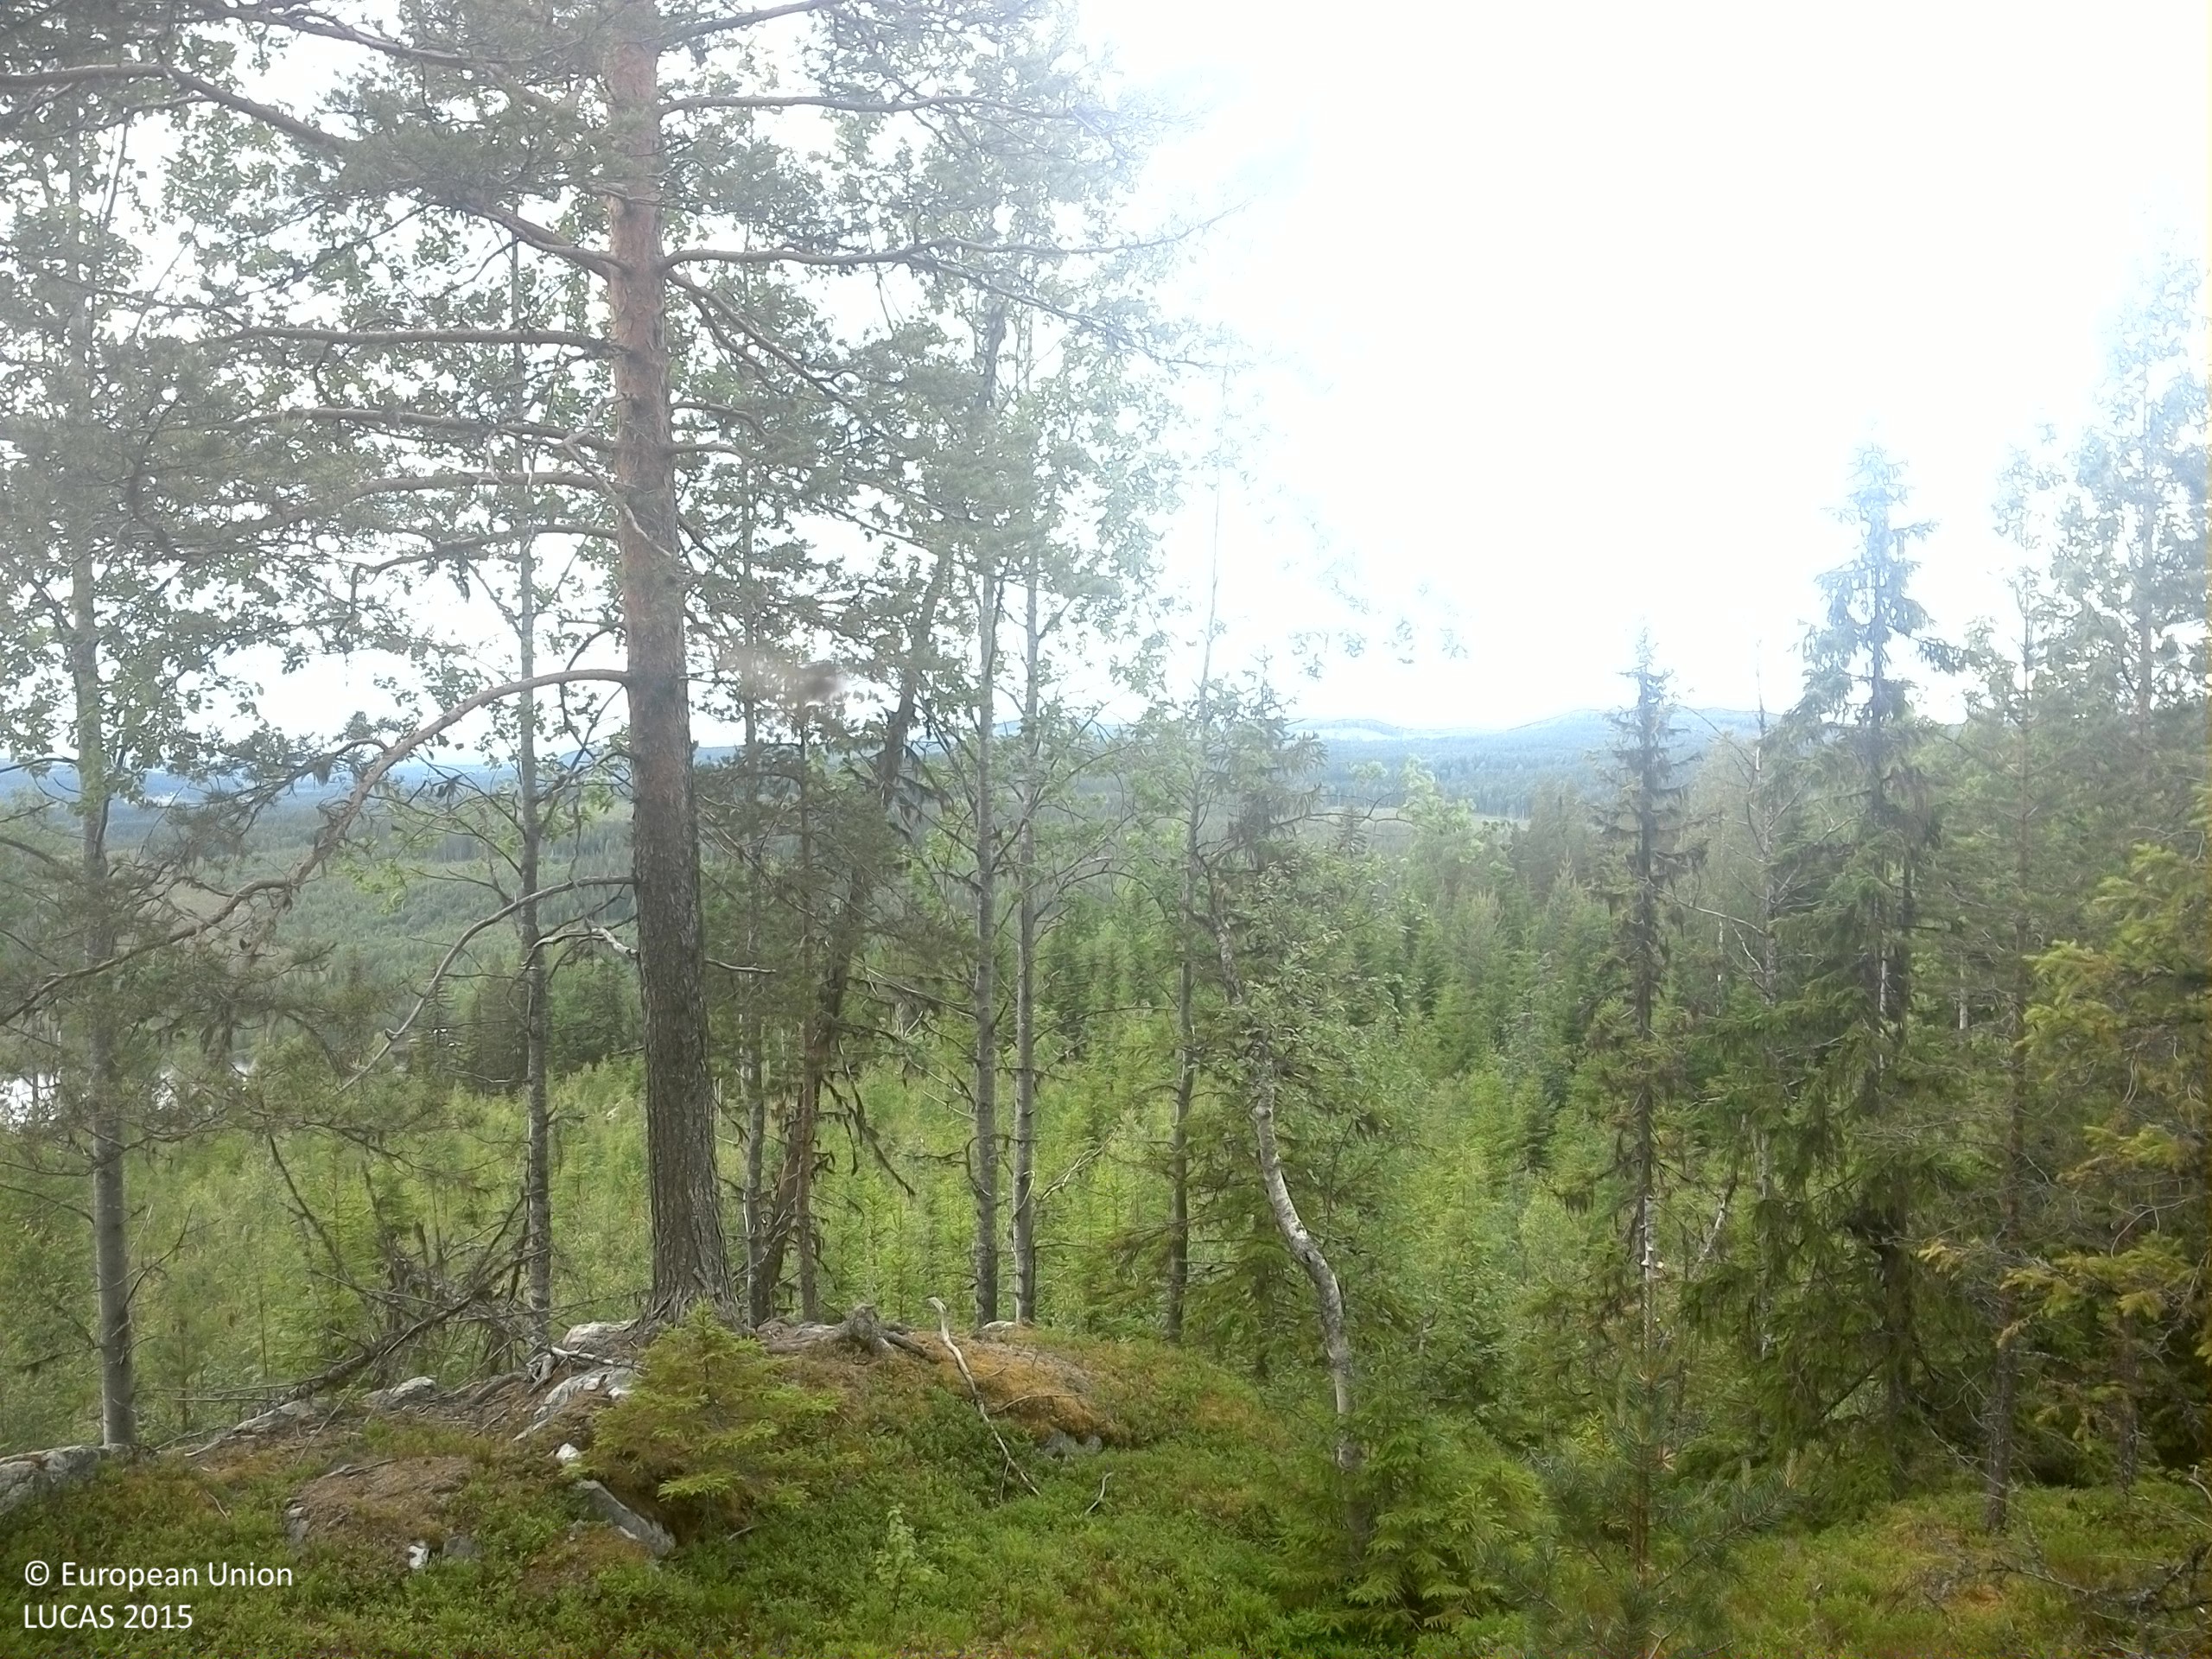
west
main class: Woodland
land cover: Pine dominated mixed woodland
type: boreal forest
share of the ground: 50 - 75 %
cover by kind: coniferous forest trees 45 %, shrubs 20 %, broadleaved forest trees 15 %, lichens and mosses 10 %, consolidated bare surface 10 %
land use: Forestry
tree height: > 5 m
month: July
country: SE
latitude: 63.5665
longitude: 17.8870
